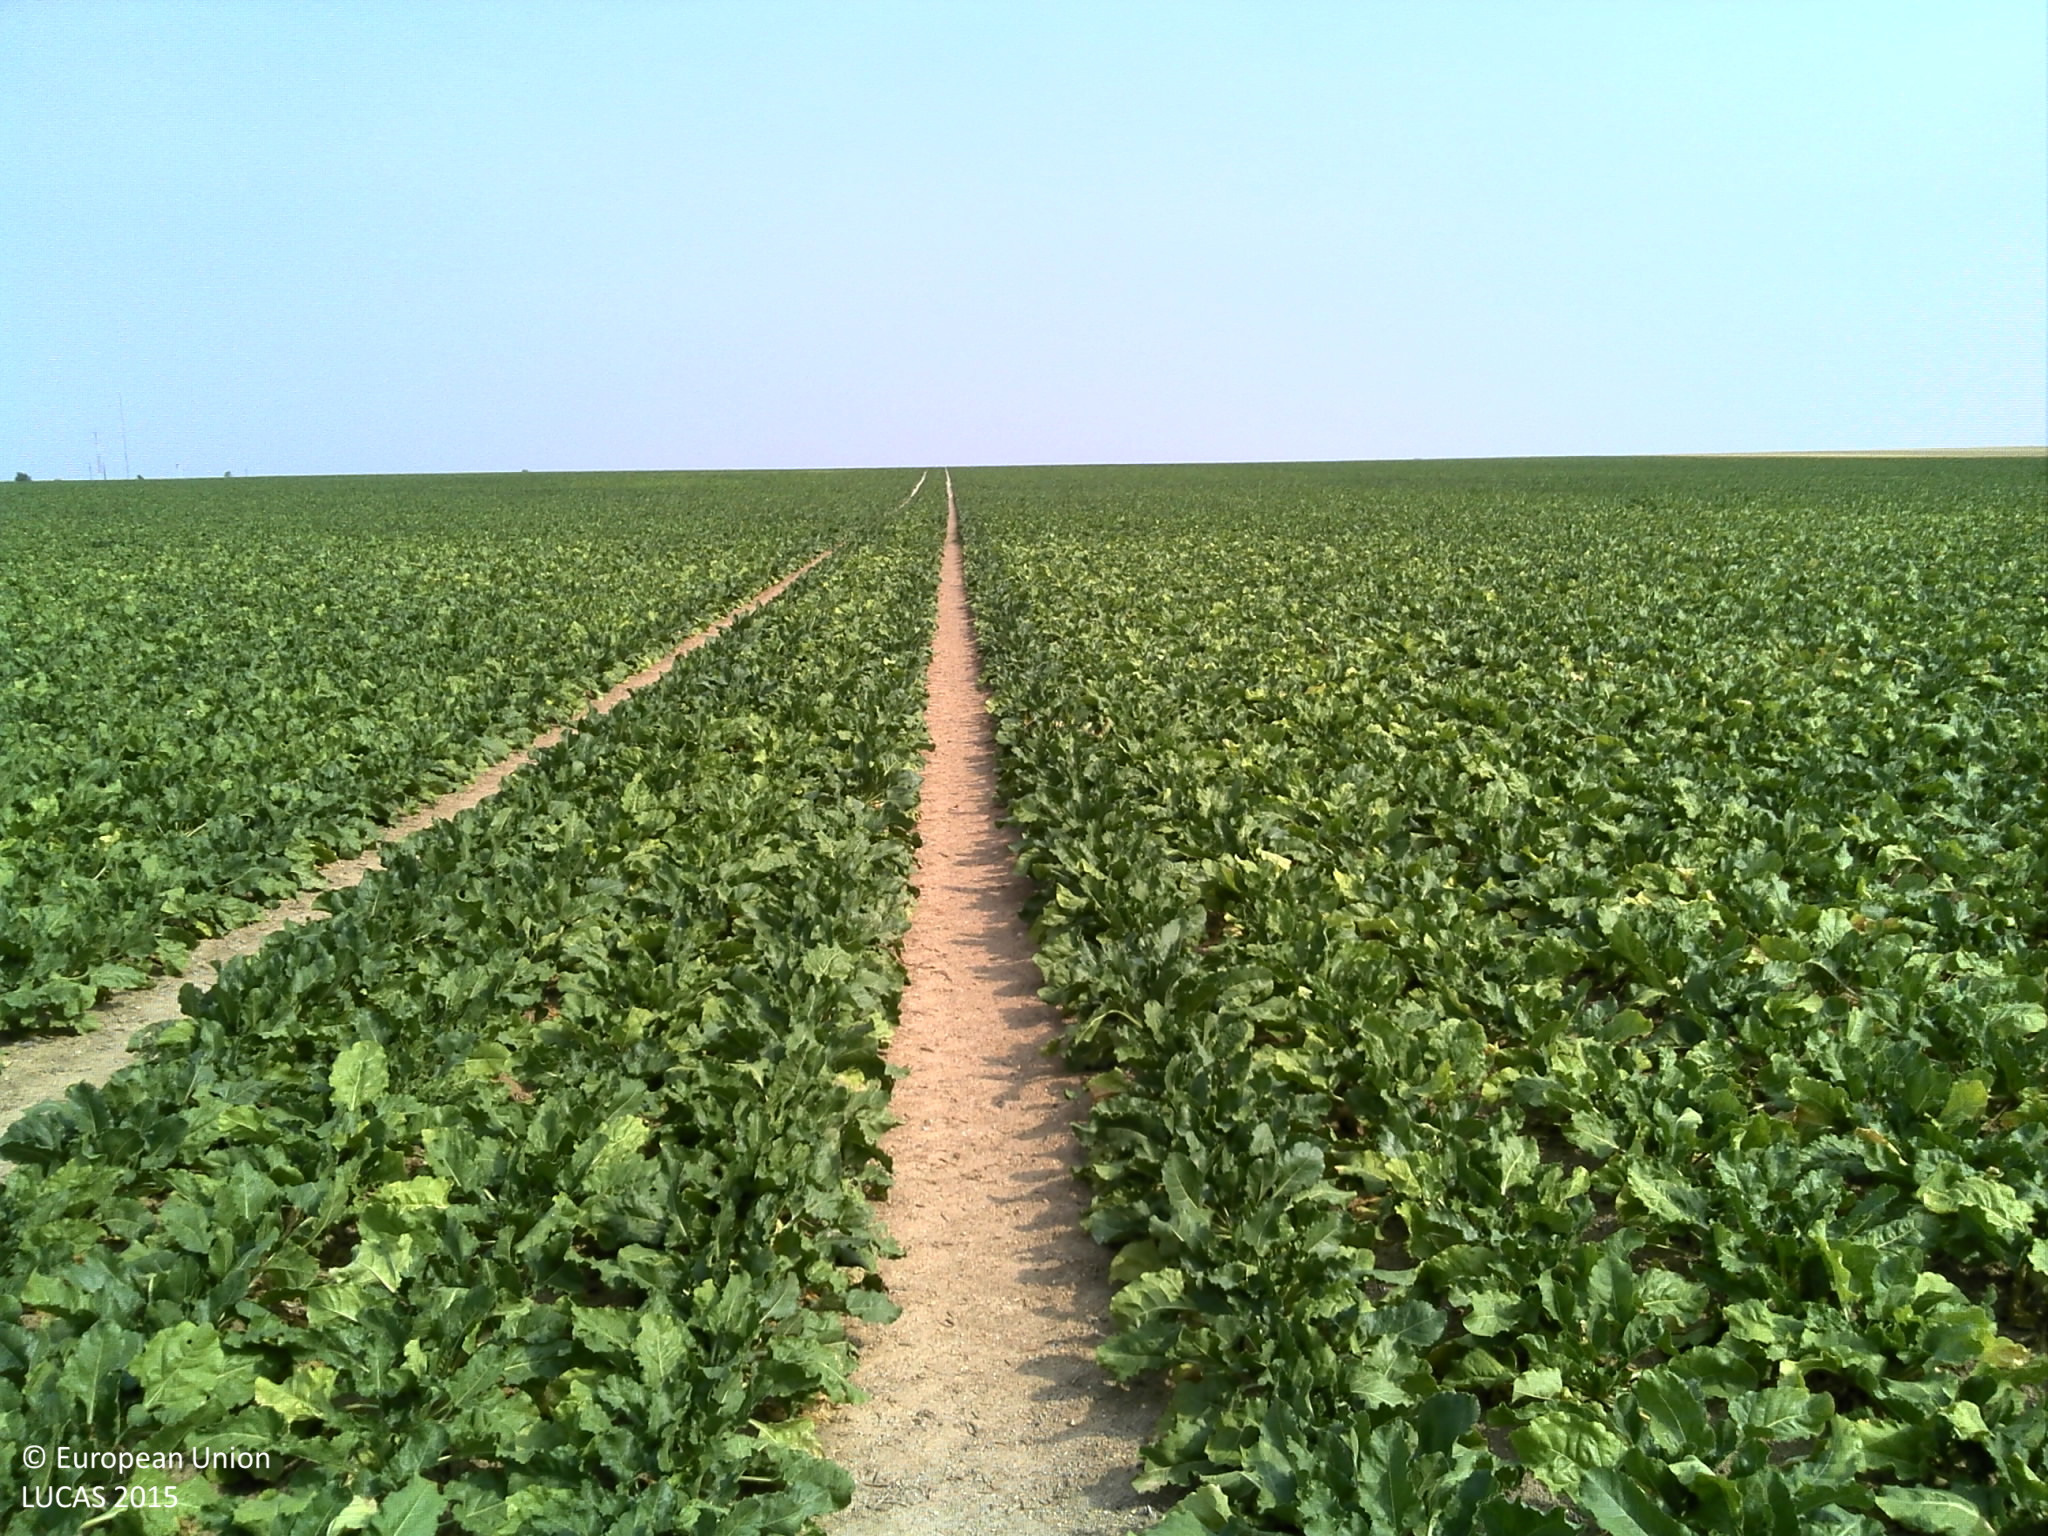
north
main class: Cropland
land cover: Sugar beet
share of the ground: 50 - 75 %
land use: Agriculture (excluding fallow land and kitchen gardens)
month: August
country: FR
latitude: 49.0299
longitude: 4.6219
